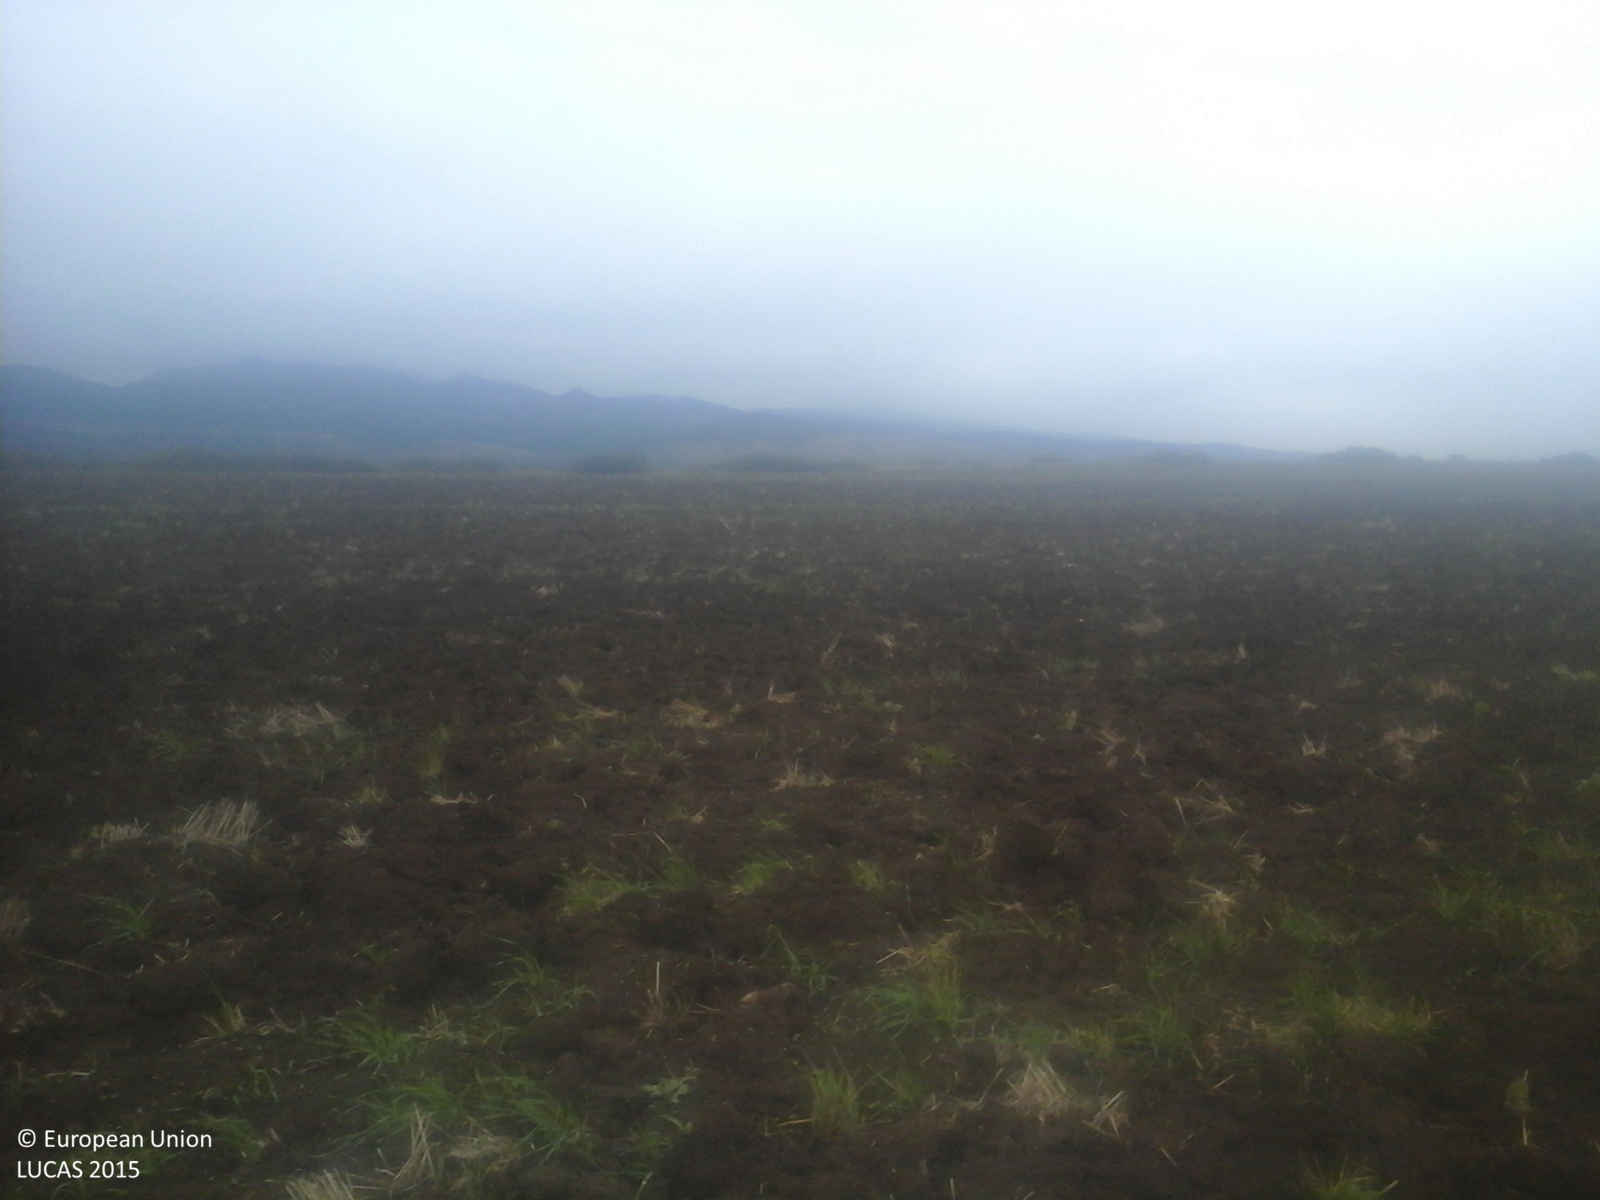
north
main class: Cropland
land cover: Common wheat
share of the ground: < 10 %
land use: Agriculture (excluding fallow land and kitchen gardens)
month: September
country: RO
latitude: 45.9543
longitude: 23.4424
